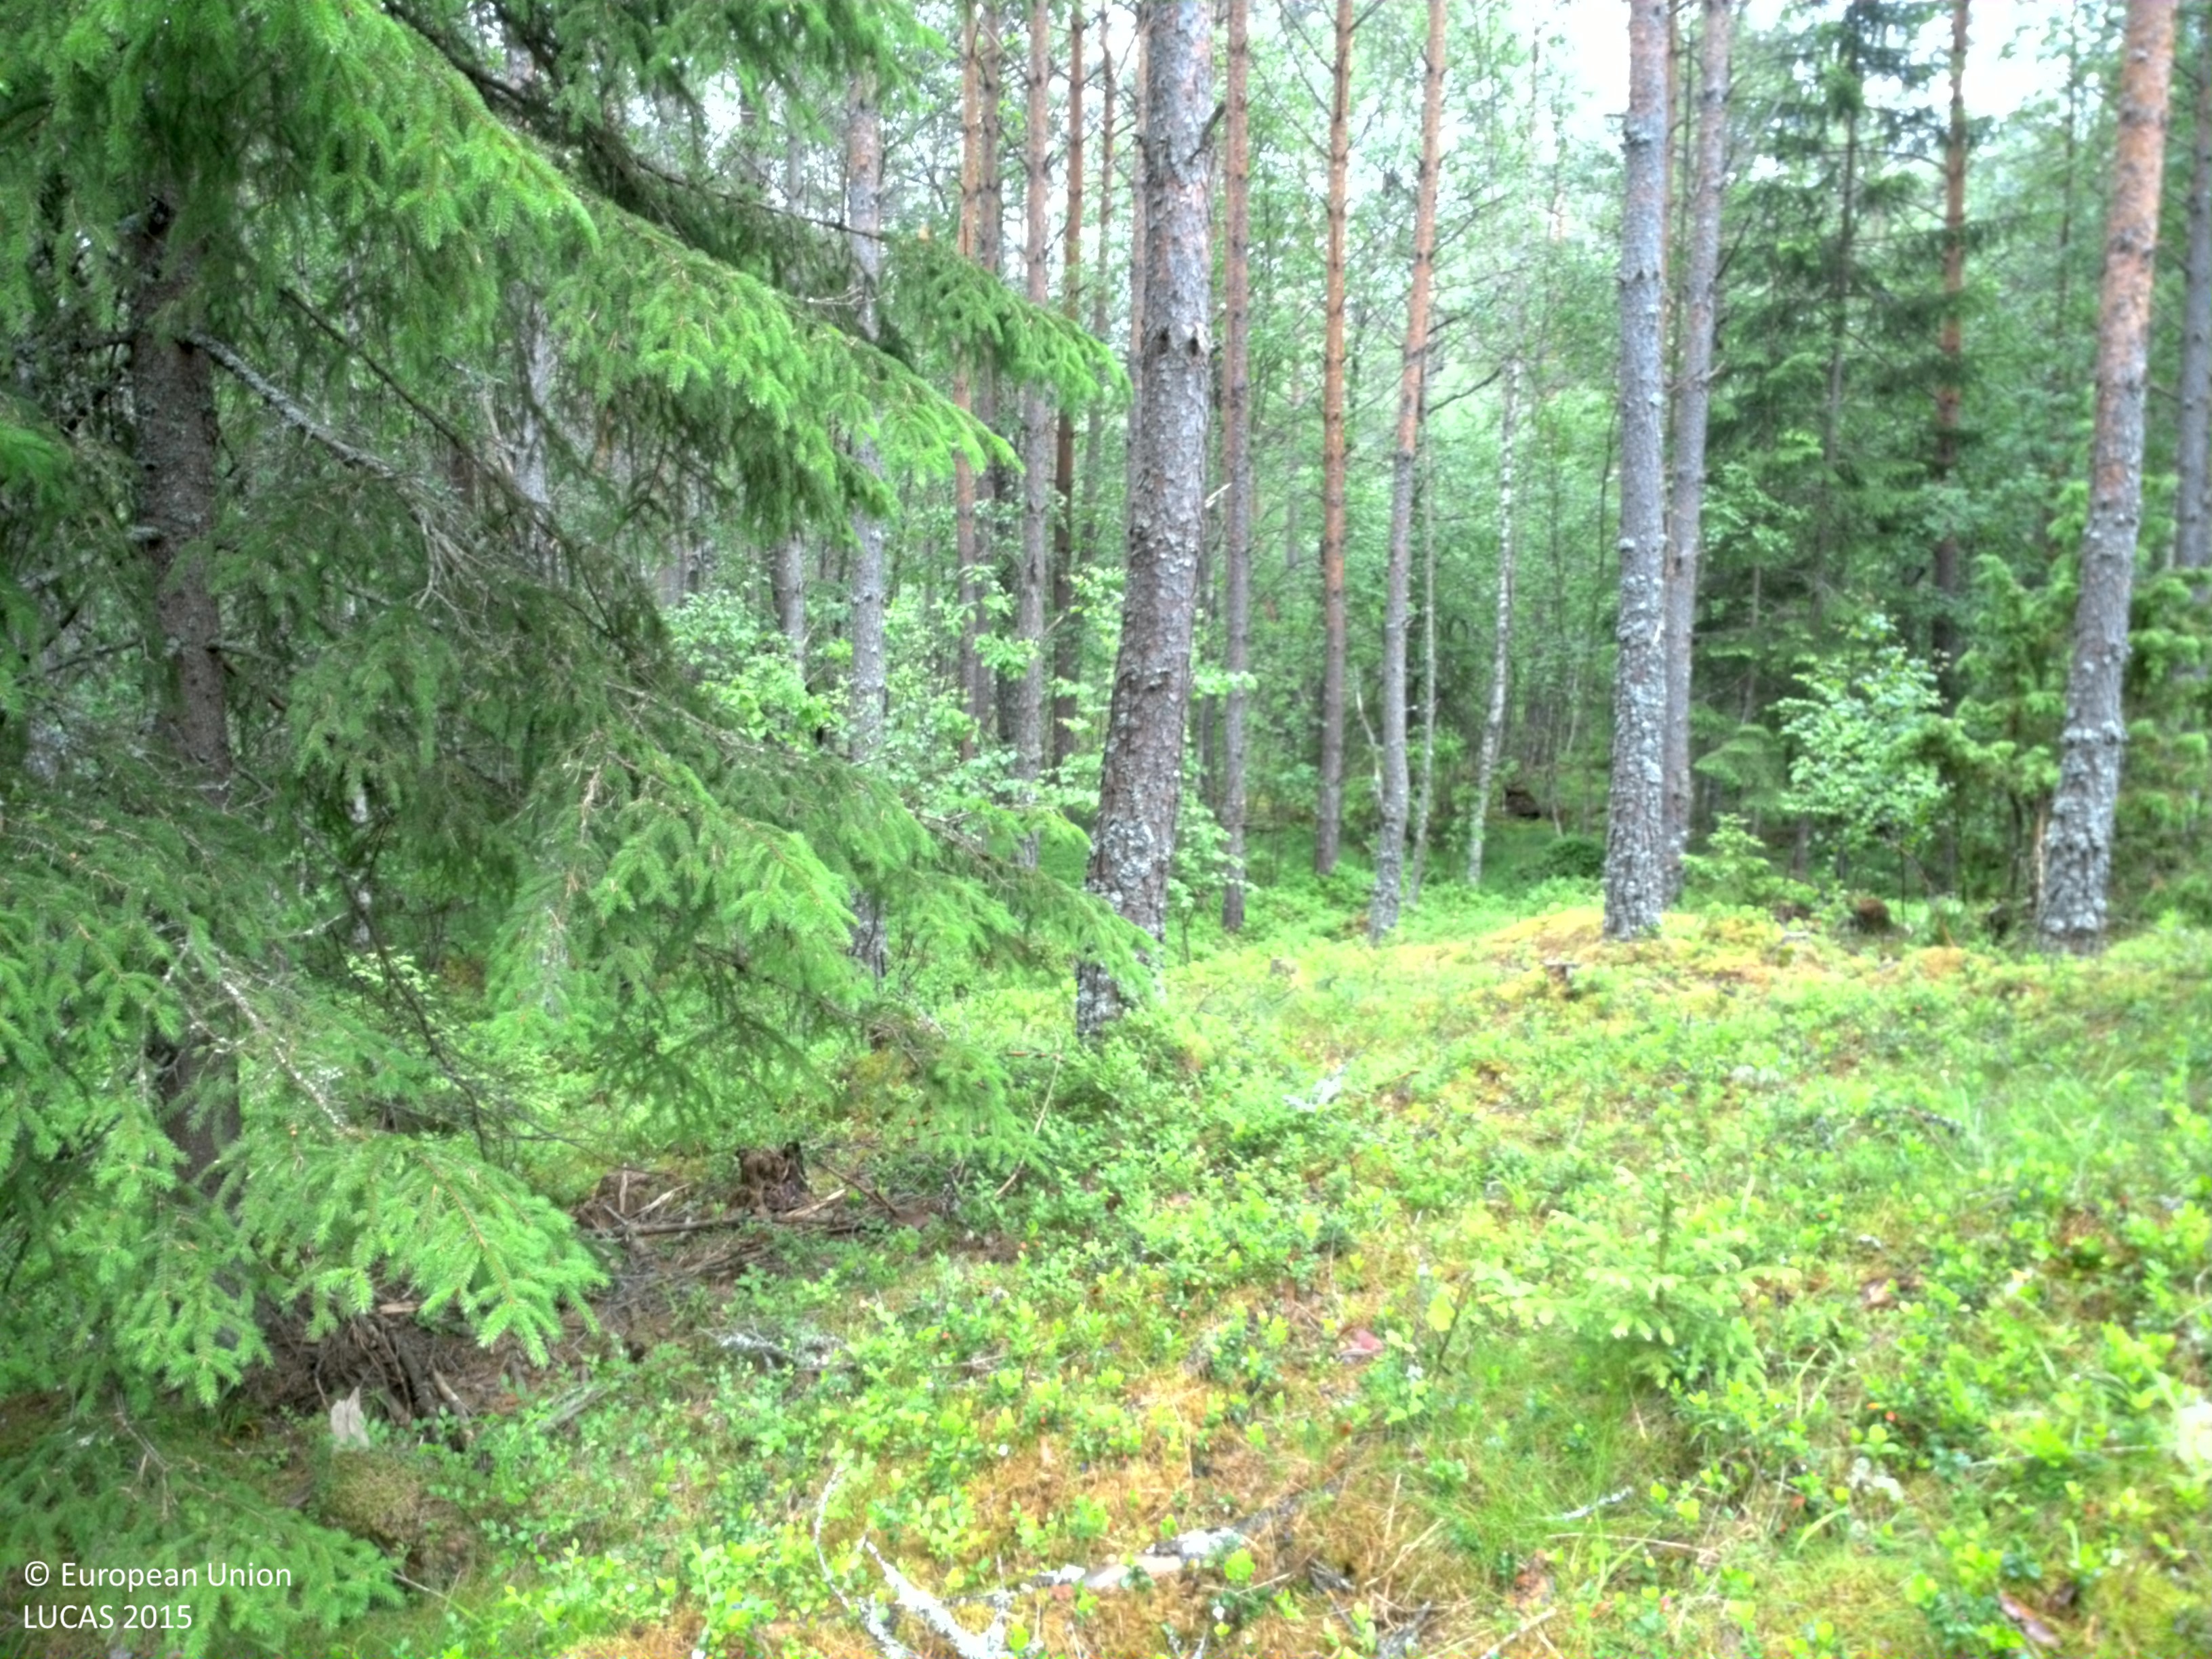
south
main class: Woodland
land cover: Pine dominated mixed woodland
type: boreal forest
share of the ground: 25 - 50 %
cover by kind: herbaceous plants 45 %, coniferous forest trees 30 %, broadleaved forest trees 15 %, lichens and mosses 10 %
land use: Forestry
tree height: > 5 m
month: June
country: SE
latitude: 58.6677
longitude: 15.4592
